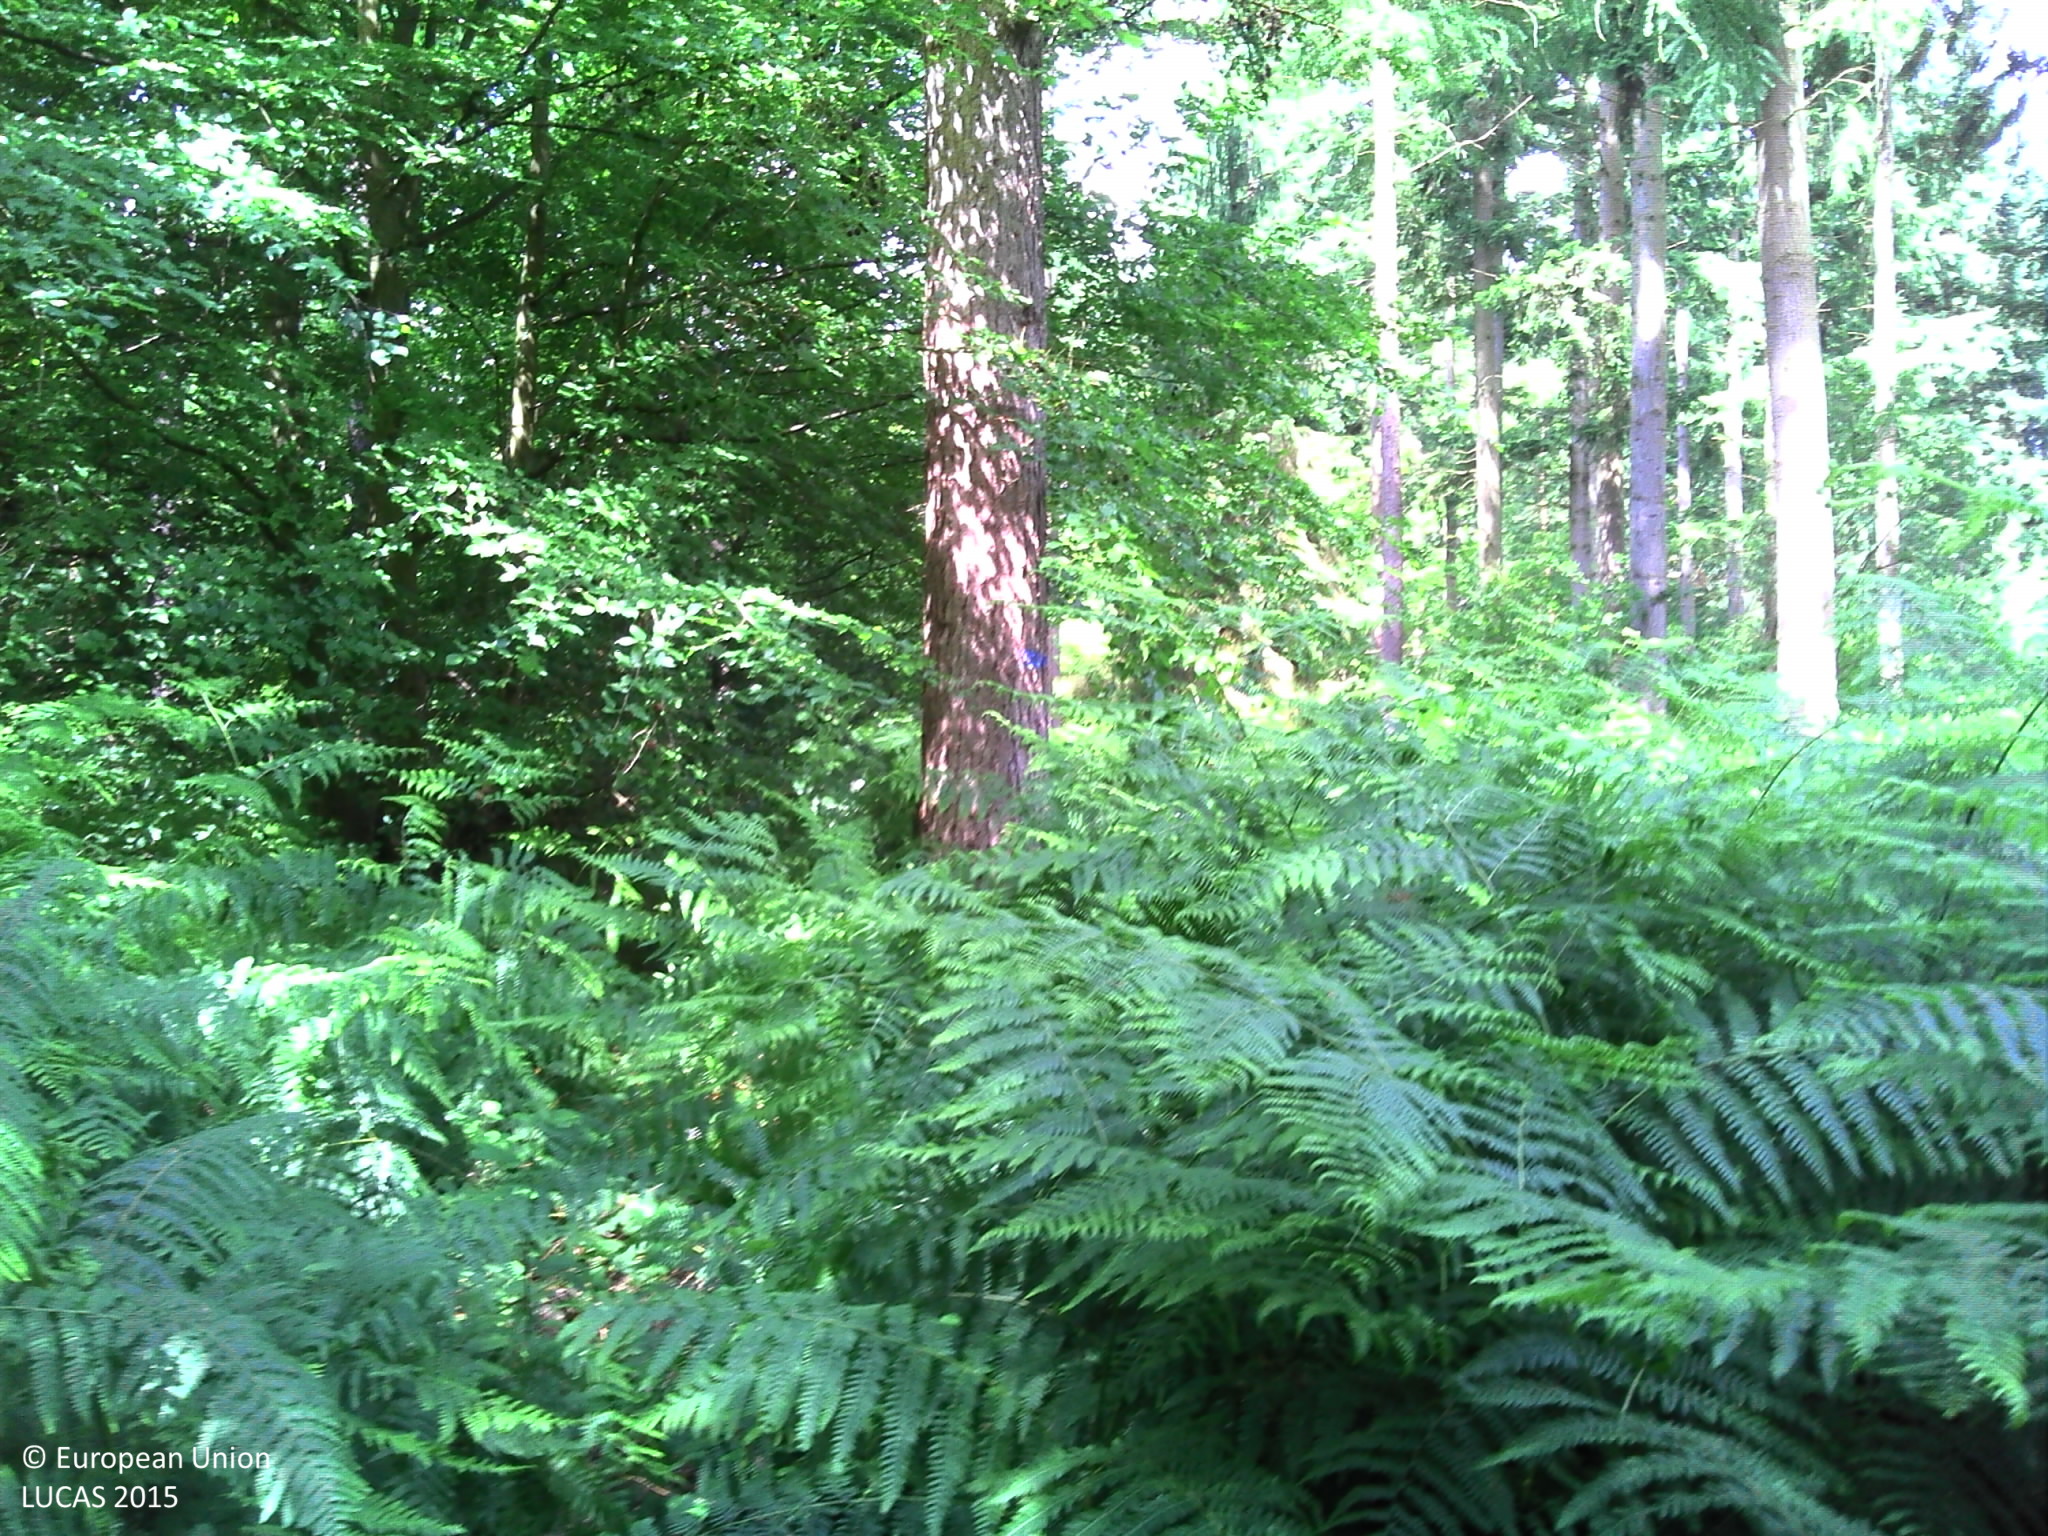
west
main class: Woodland
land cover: Spruce dominated mixed woodland
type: mesophytic deciduous forest
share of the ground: > 75 %
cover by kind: broadleaved forest trees 50 %, coniferous forest trees 40 %, herbaceous plants 10 %
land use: Forestry
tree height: > 5 m
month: June
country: FR
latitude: 49.2422
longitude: 1.1471
